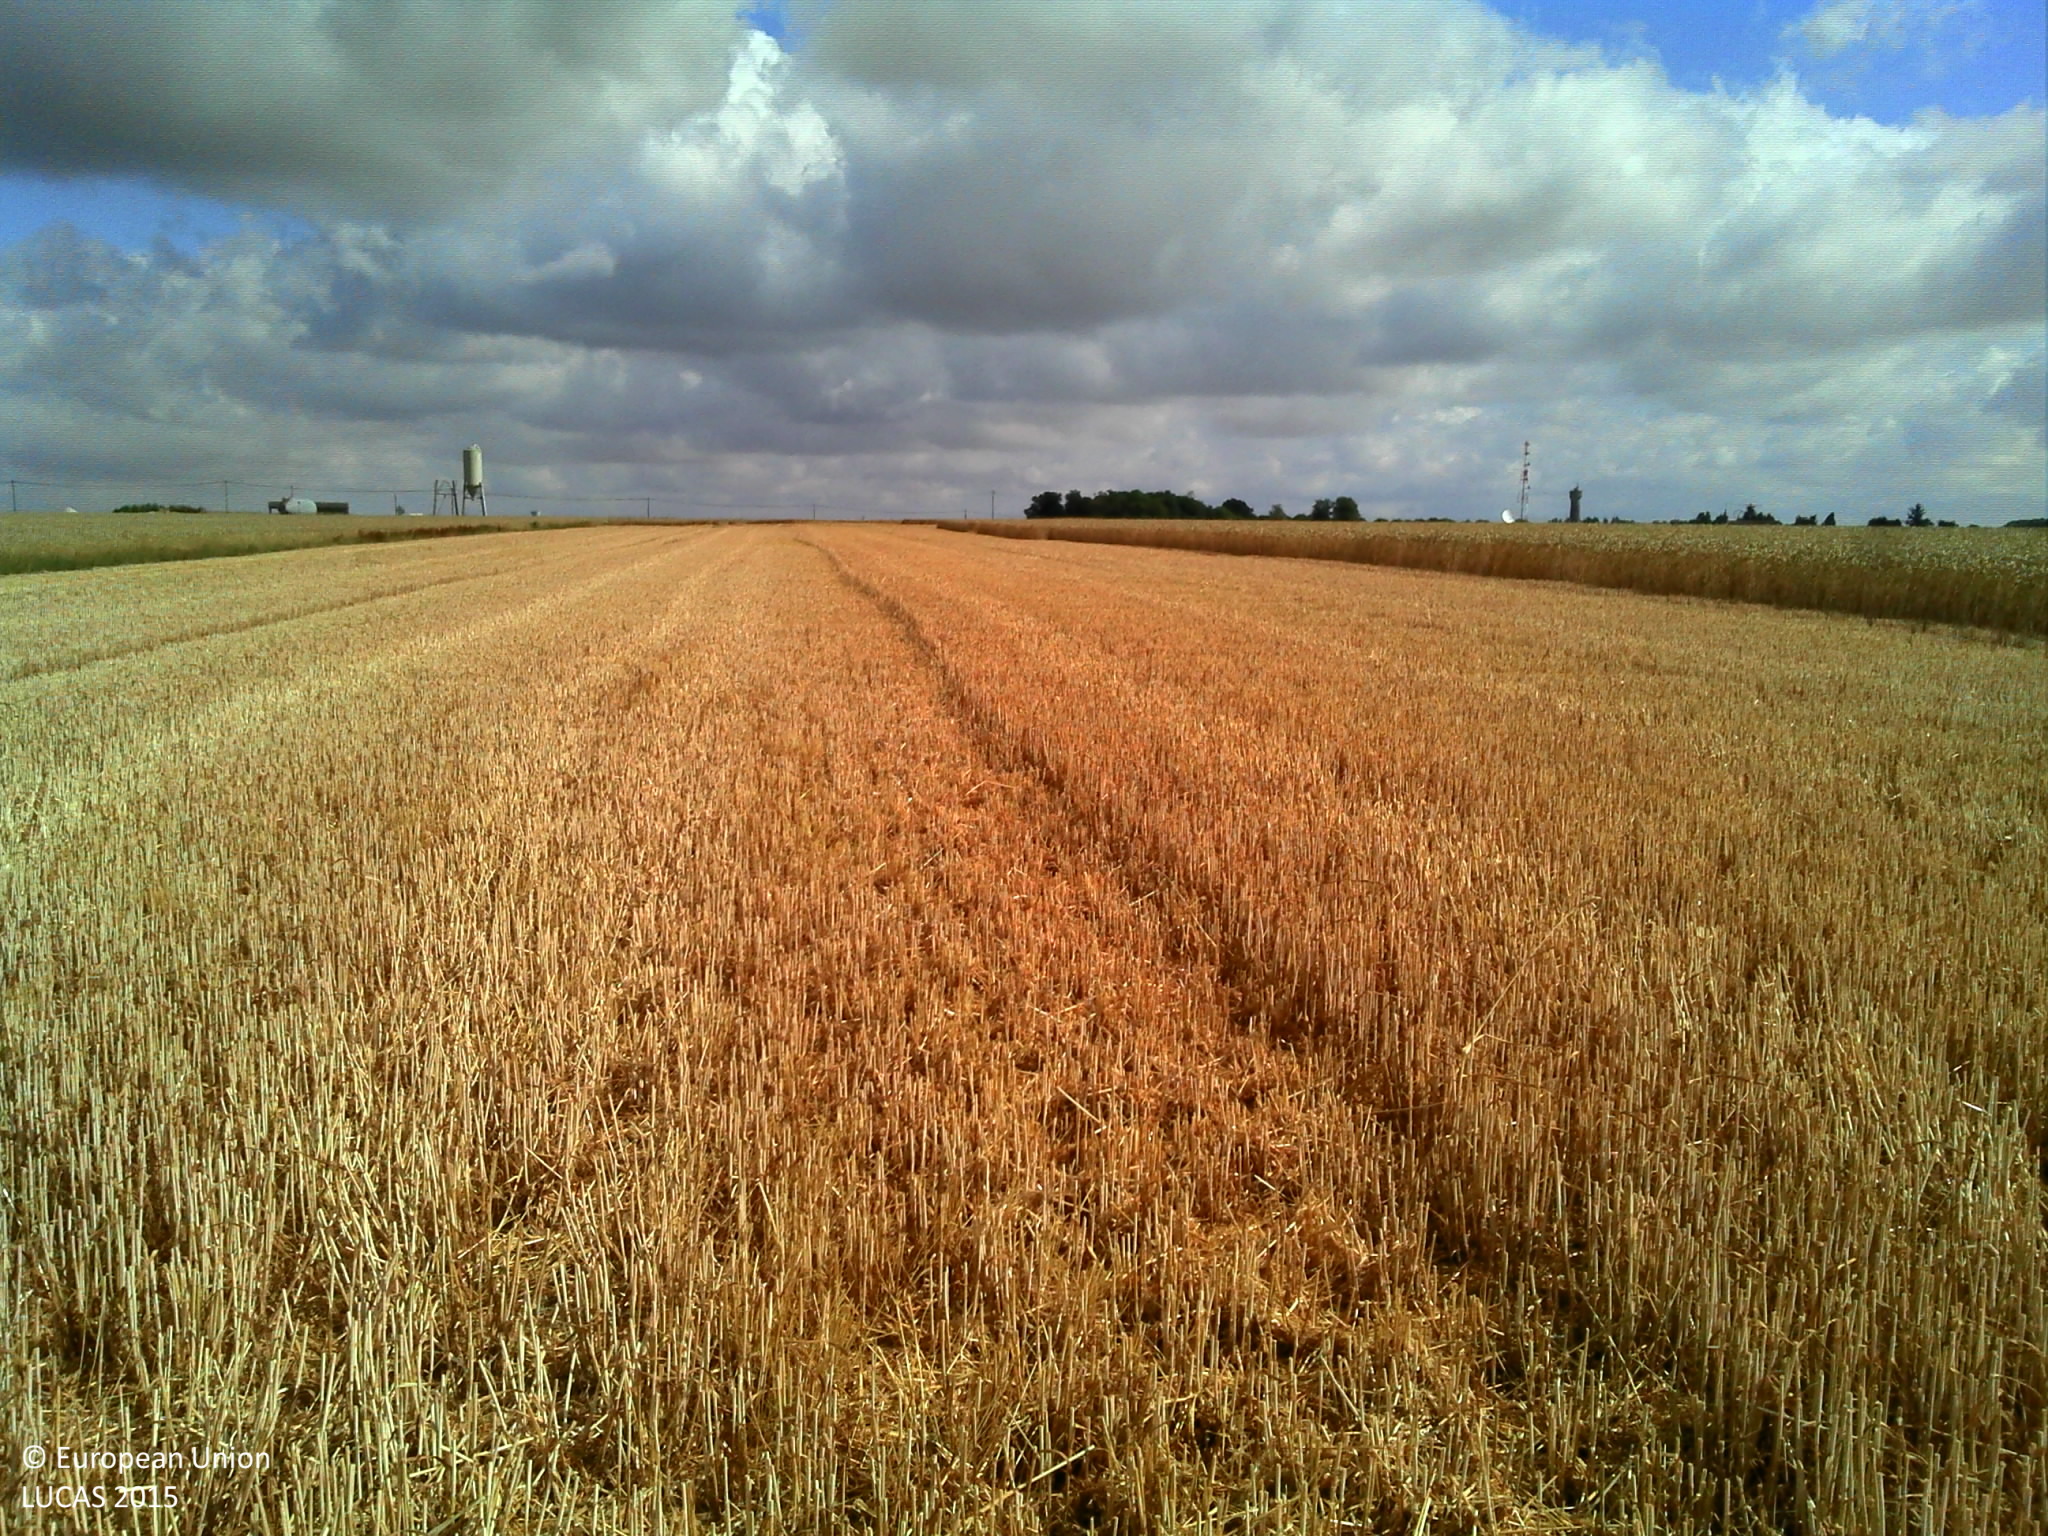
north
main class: Cropland
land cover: Common wheat
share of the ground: > 75 %
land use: Agriculture (excluding fallow land and kitchen gardens)
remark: Harvested field
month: July
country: FR
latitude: 48.5243
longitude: 1.2206
